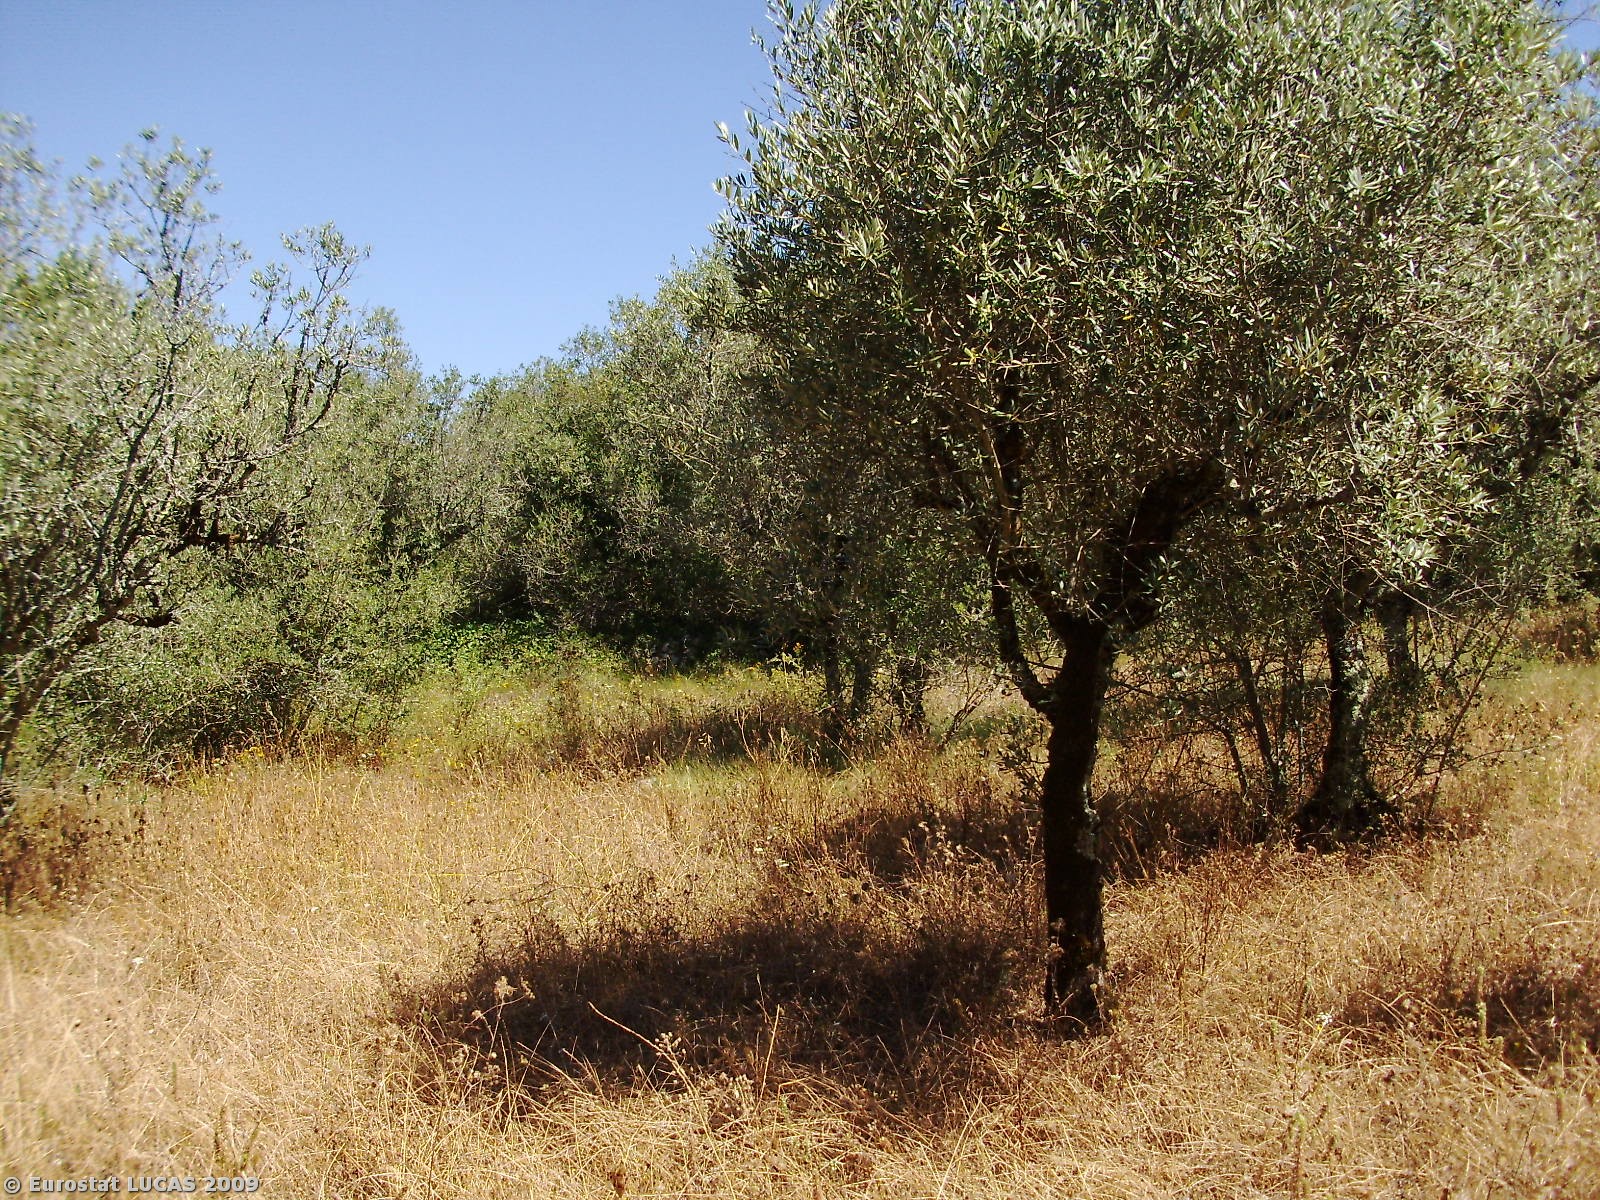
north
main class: Cropland
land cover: Olive groves
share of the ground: 25 - 50 %
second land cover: Spontaneously vegetated surfaces
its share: 50 - 75 %
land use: Agriculture (excluding fallow land and kitchen gardens)
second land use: Fallow land
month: July
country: PT
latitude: 39.5106
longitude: -8.8667
